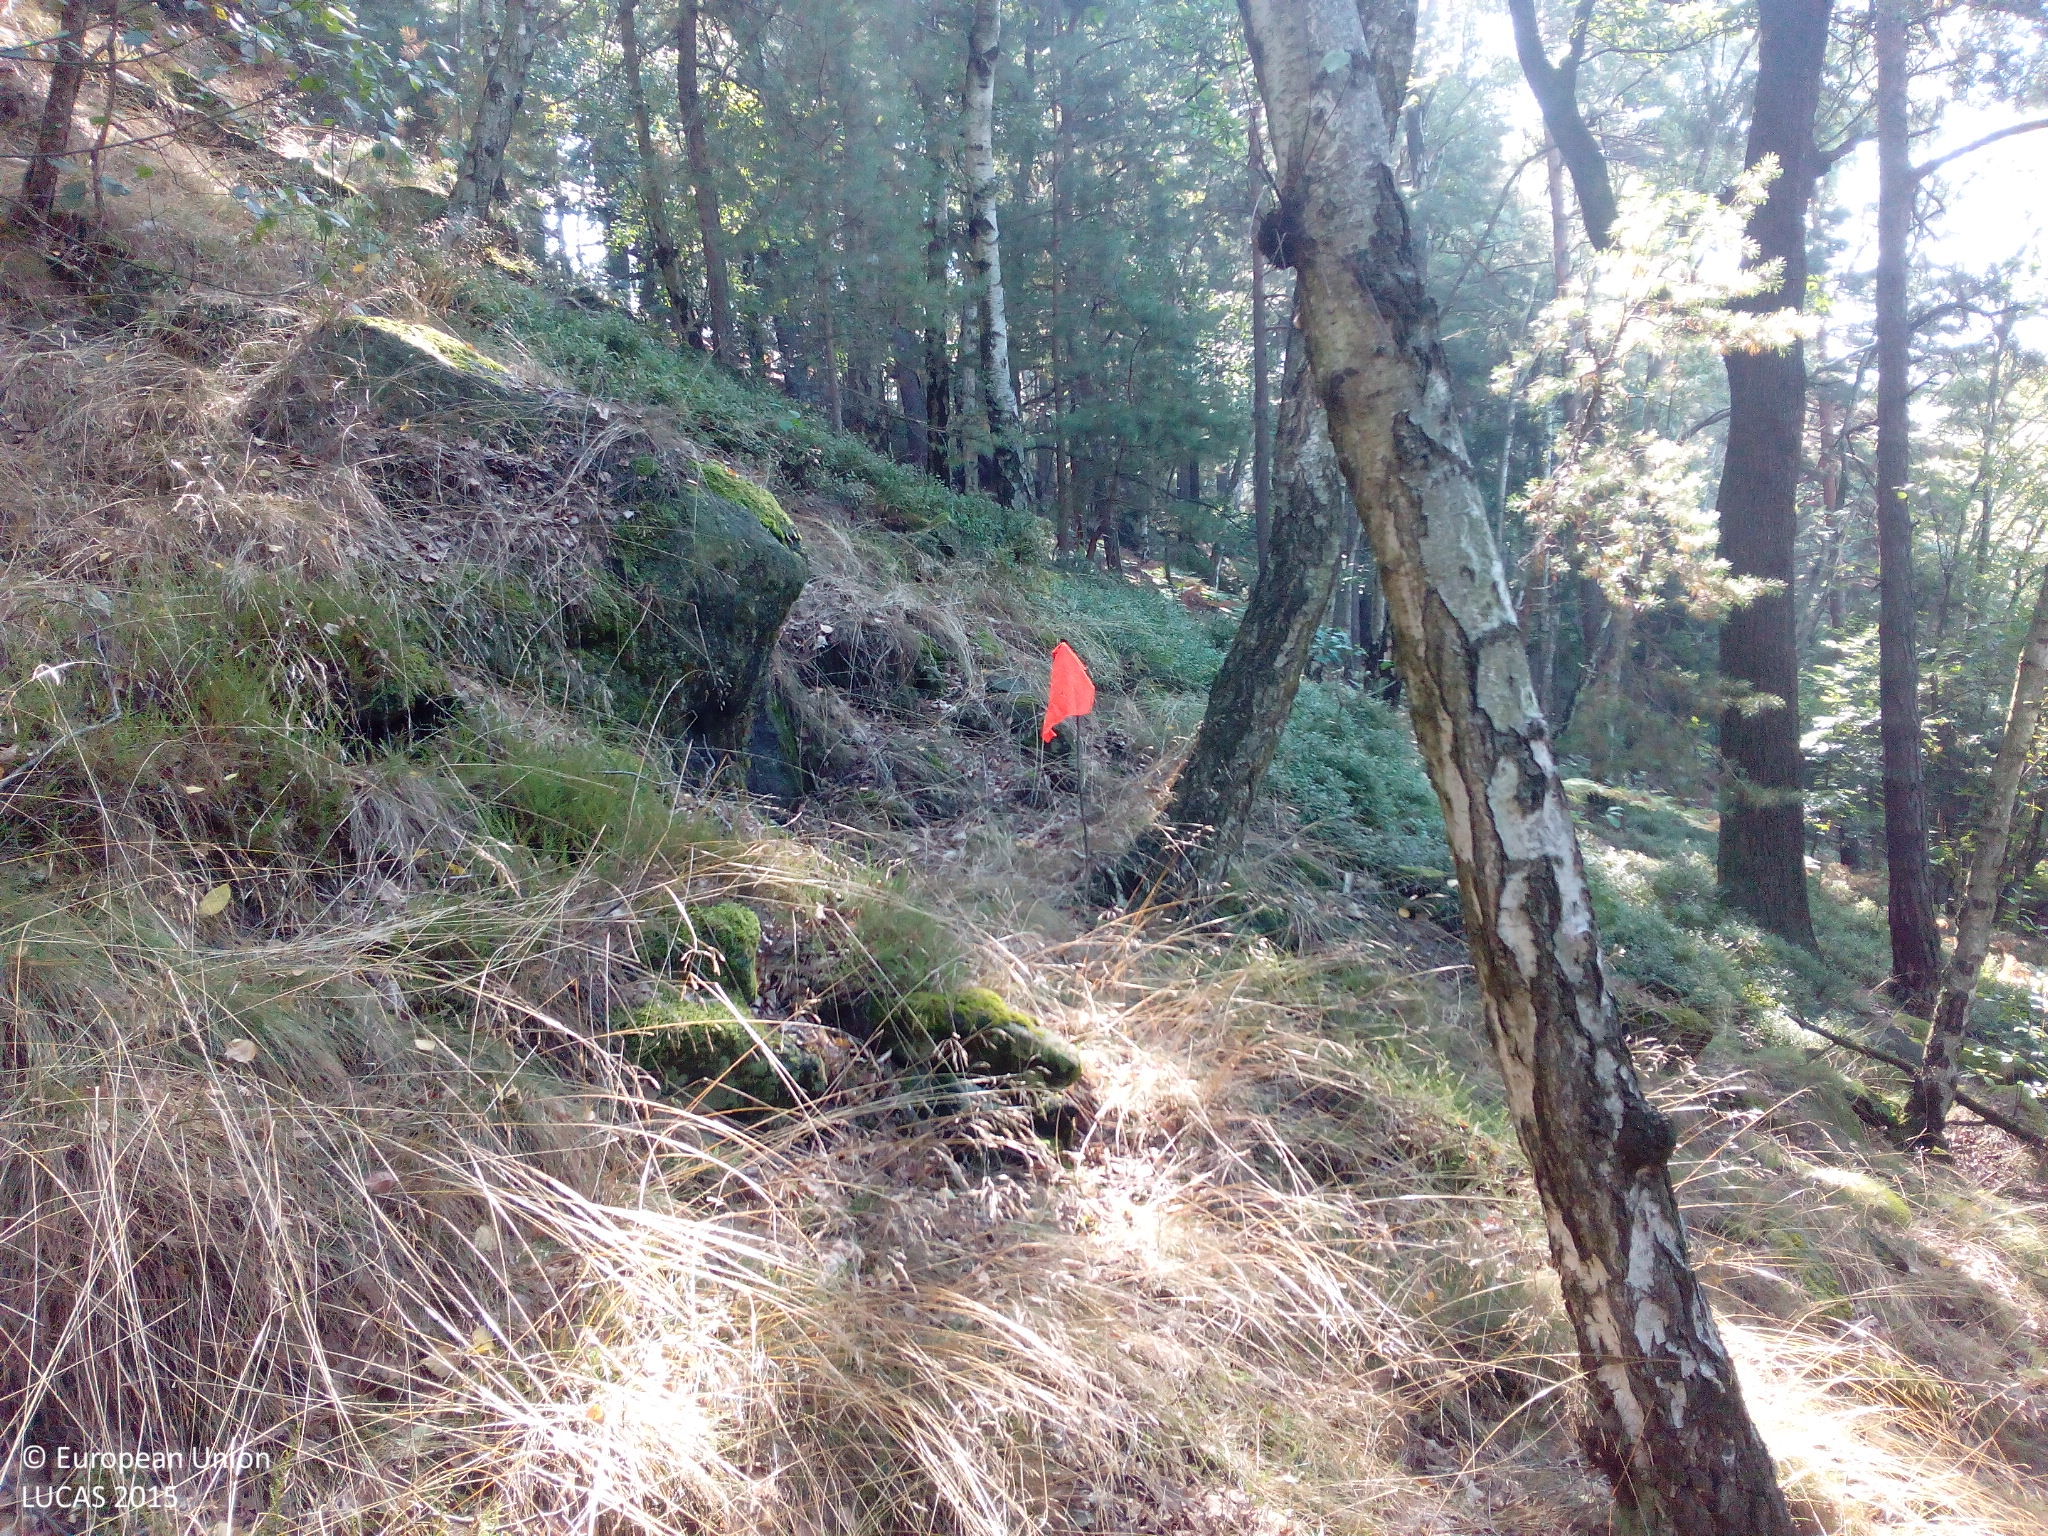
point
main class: Woodland
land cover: Pine dominated mixed woodland
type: hemiboreal forest and nemoral coniferous forest and mixed broadleaved-coniferous forest
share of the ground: > 75 %
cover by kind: coniferous forest trees 60 %, broadleaved forest trees 40 %
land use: Forestry
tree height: > 5 m
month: August
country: DE
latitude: 50.9063
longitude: 13.9971
